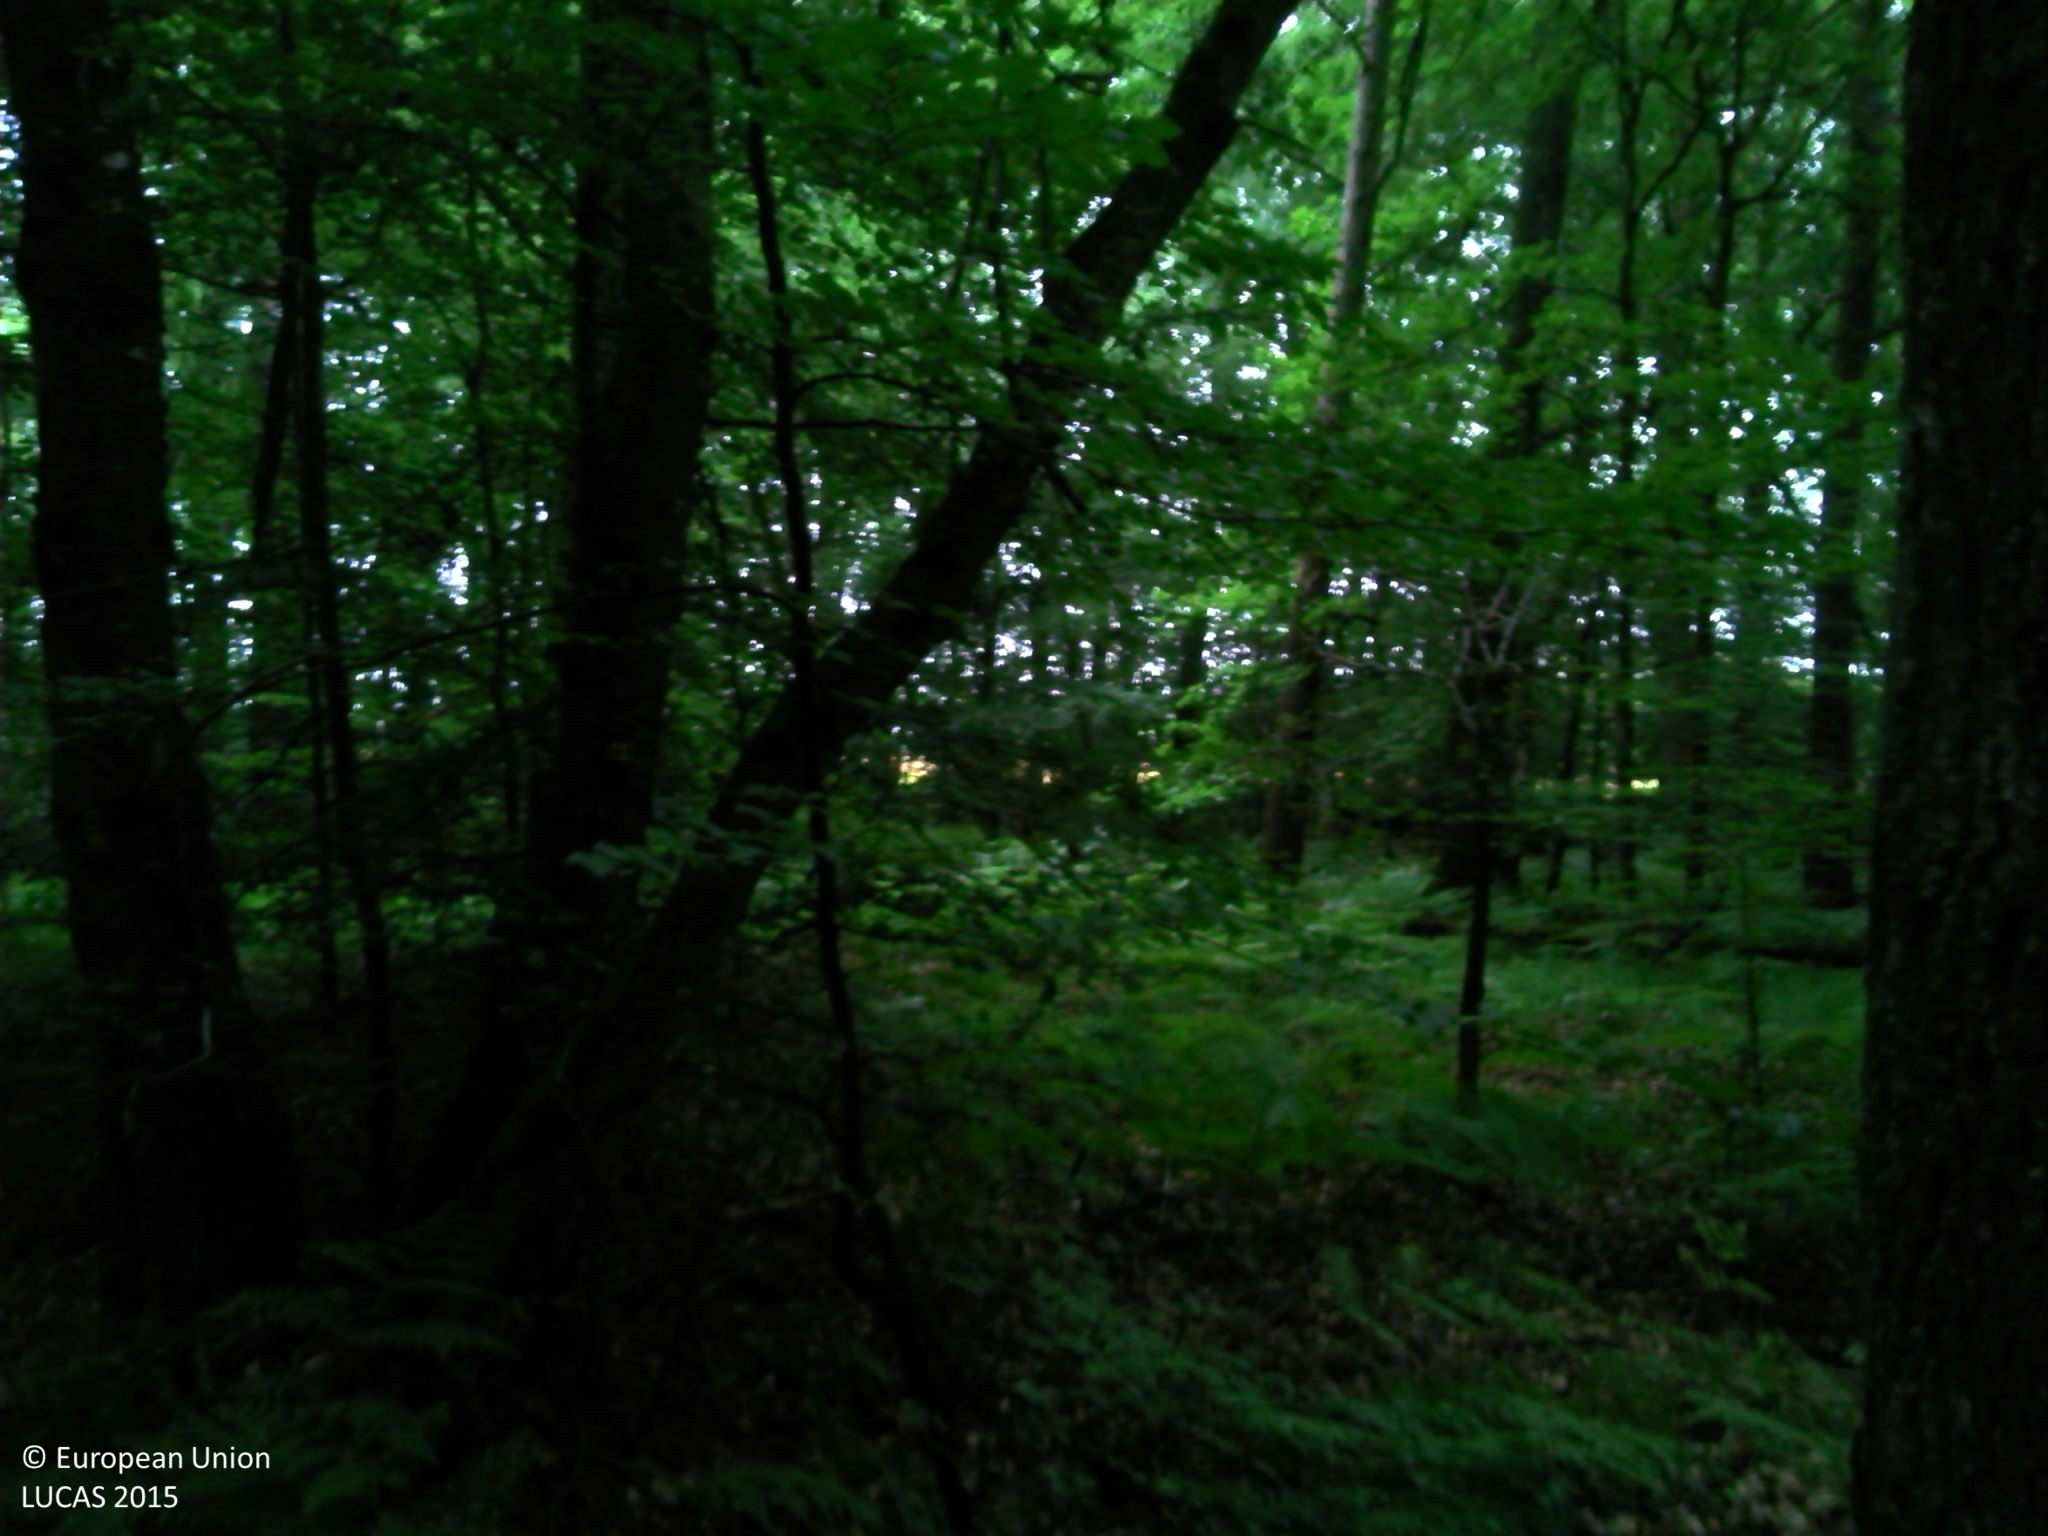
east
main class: Woodland
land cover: Broadleaved woodland
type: acidophilous oak and oak-birch forest
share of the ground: > 75 %
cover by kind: broadleaved forest trees 95 %, herbaceous plants 5 %
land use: Forestry
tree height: > 5 m
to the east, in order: Broadleaved woodland; Ditches and canals; Grassland without tree/shrub cover; Barley; Grass margins; Ditches and canals; Broadleaved woodland
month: July
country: FR
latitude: 48.9228
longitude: -0.2554
